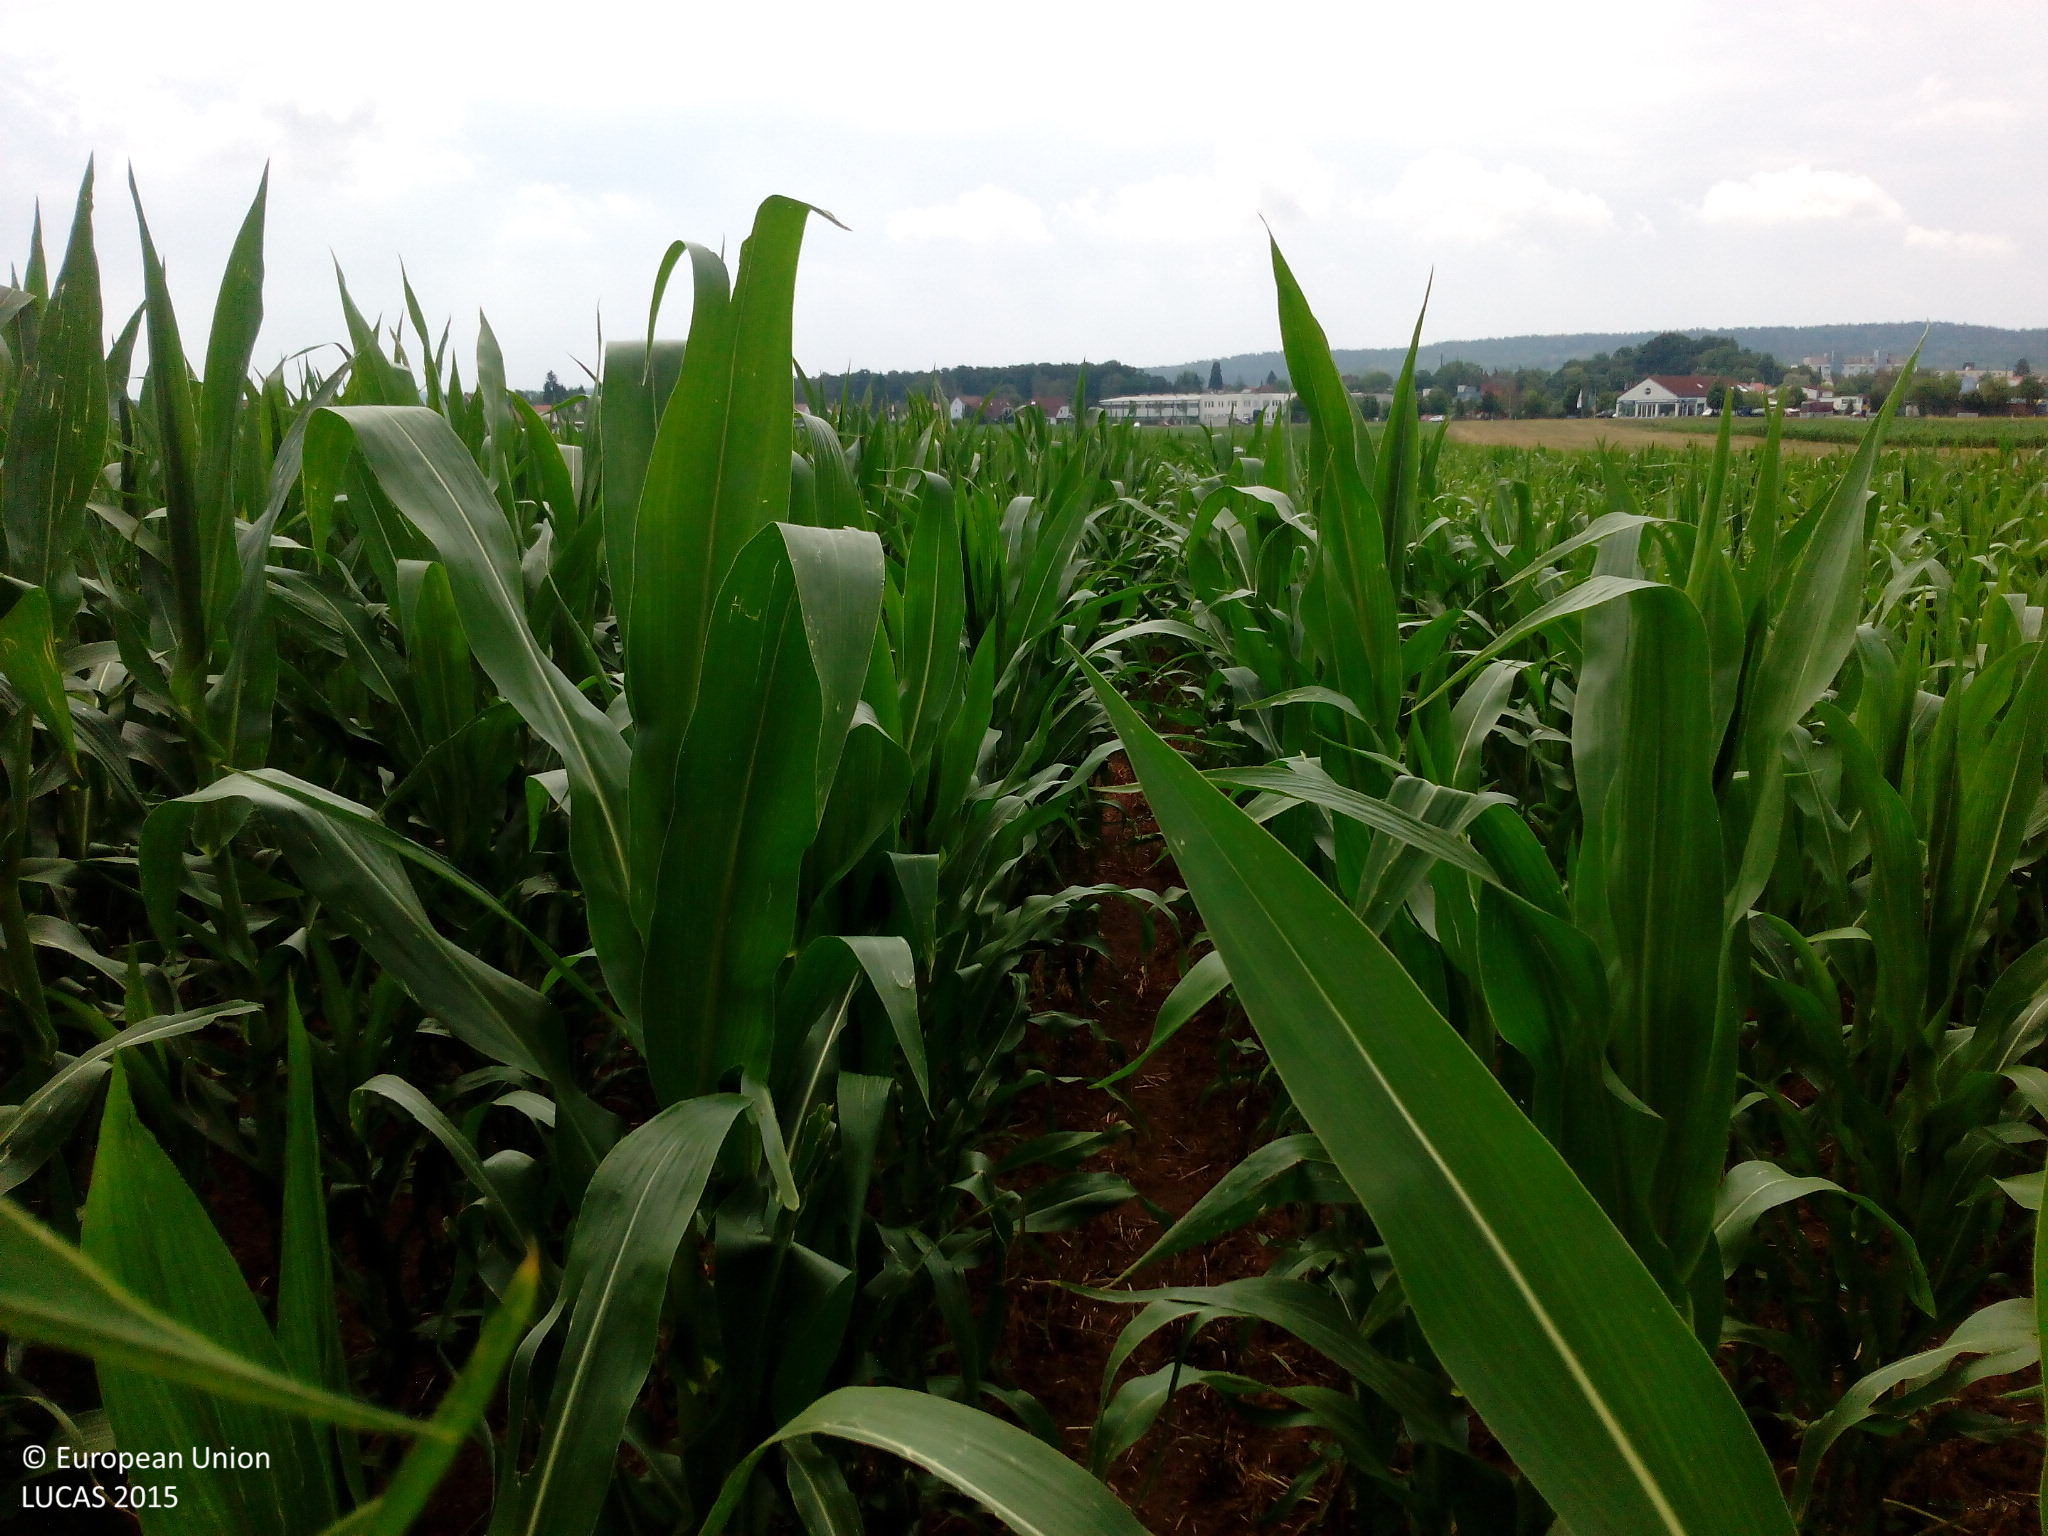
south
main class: Cropland
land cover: Maize
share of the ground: > 75 %
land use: Agriculture (excluding fallow land and kitchen gardens)
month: July
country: DE
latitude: 49.4971
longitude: 10.9247
